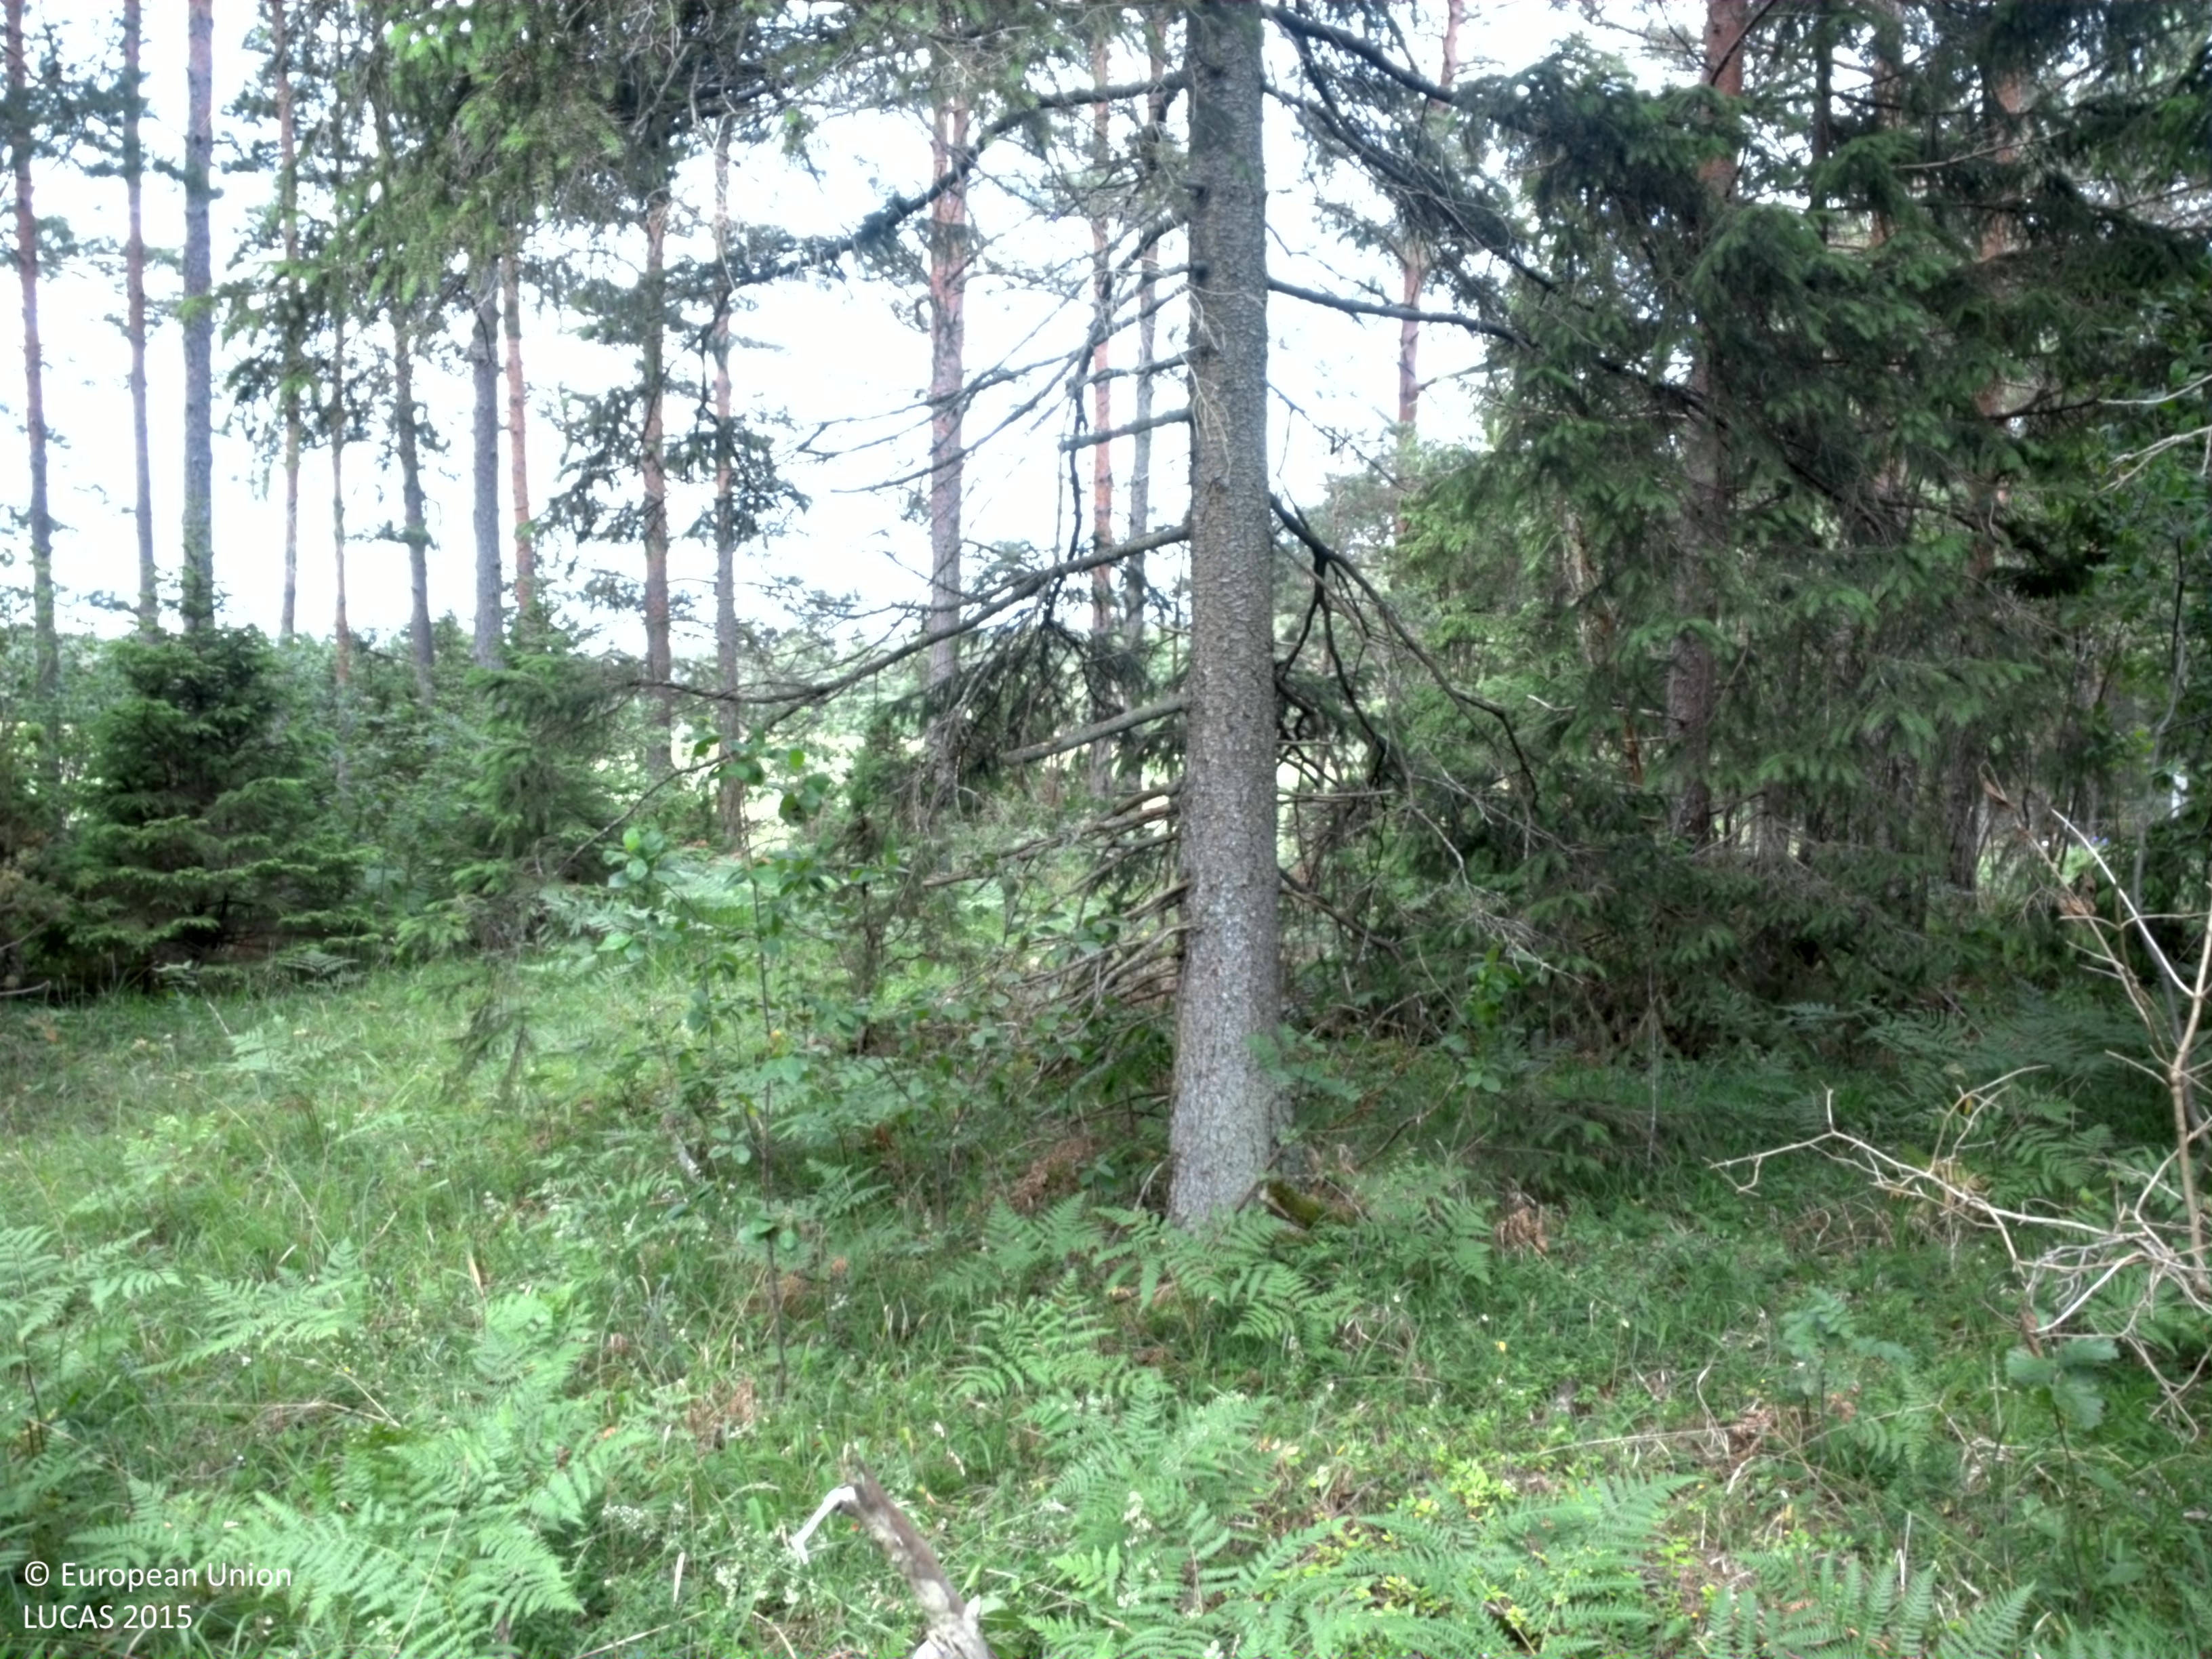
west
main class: Woodland
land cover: Pine dominated coniferous woodland
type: hemiboreal forest and nemoral coniferous forest and mixed broadleaved-coniferous forest
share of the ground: > 75 %
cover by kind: coniferous forest trees 75 %, herbaceous plants 15 %, shrubs 5 %, unconsolidated bare surface 5 %
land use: Forestry
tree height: > 5 m
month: July
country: SE
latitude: 57.5536
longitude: 18.7504
